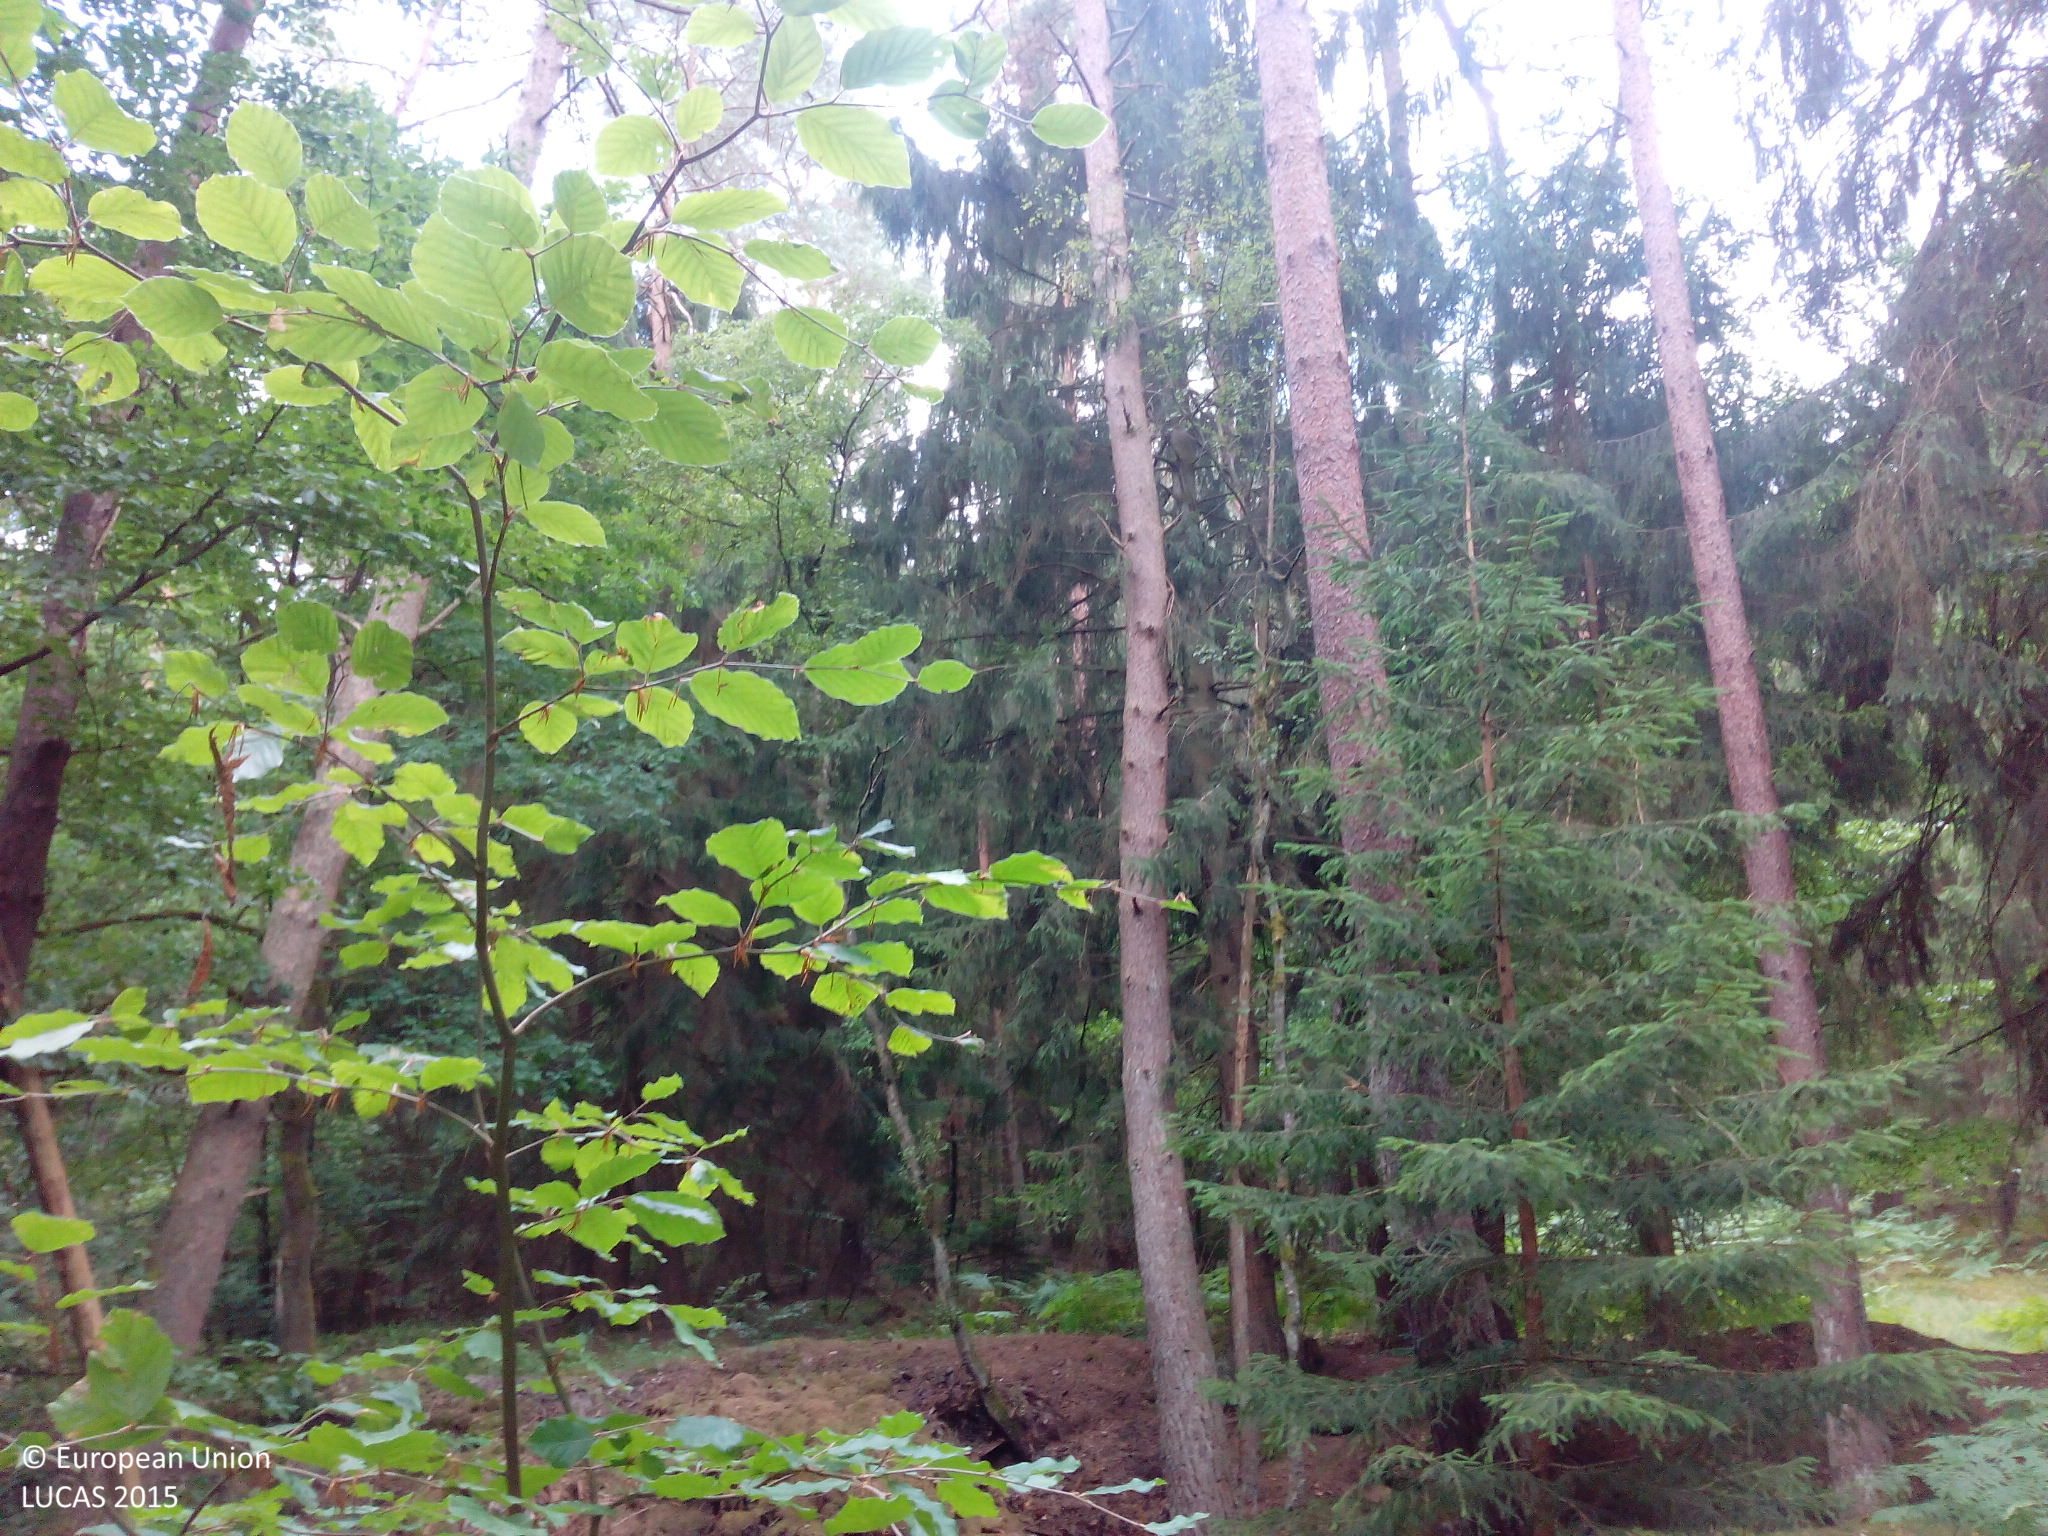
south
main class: Woodland
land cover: Other coniferous woodland
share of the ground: > 75 %
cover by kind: coniferous forest trees 70 %, broadleaved forest trees 15 %, shrubs 5 %, herbaceous plants 5 %, unconsolidated bare surface 5 %
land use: Forestry
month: July
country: DE
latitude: 49.1143
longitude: 7.5482
